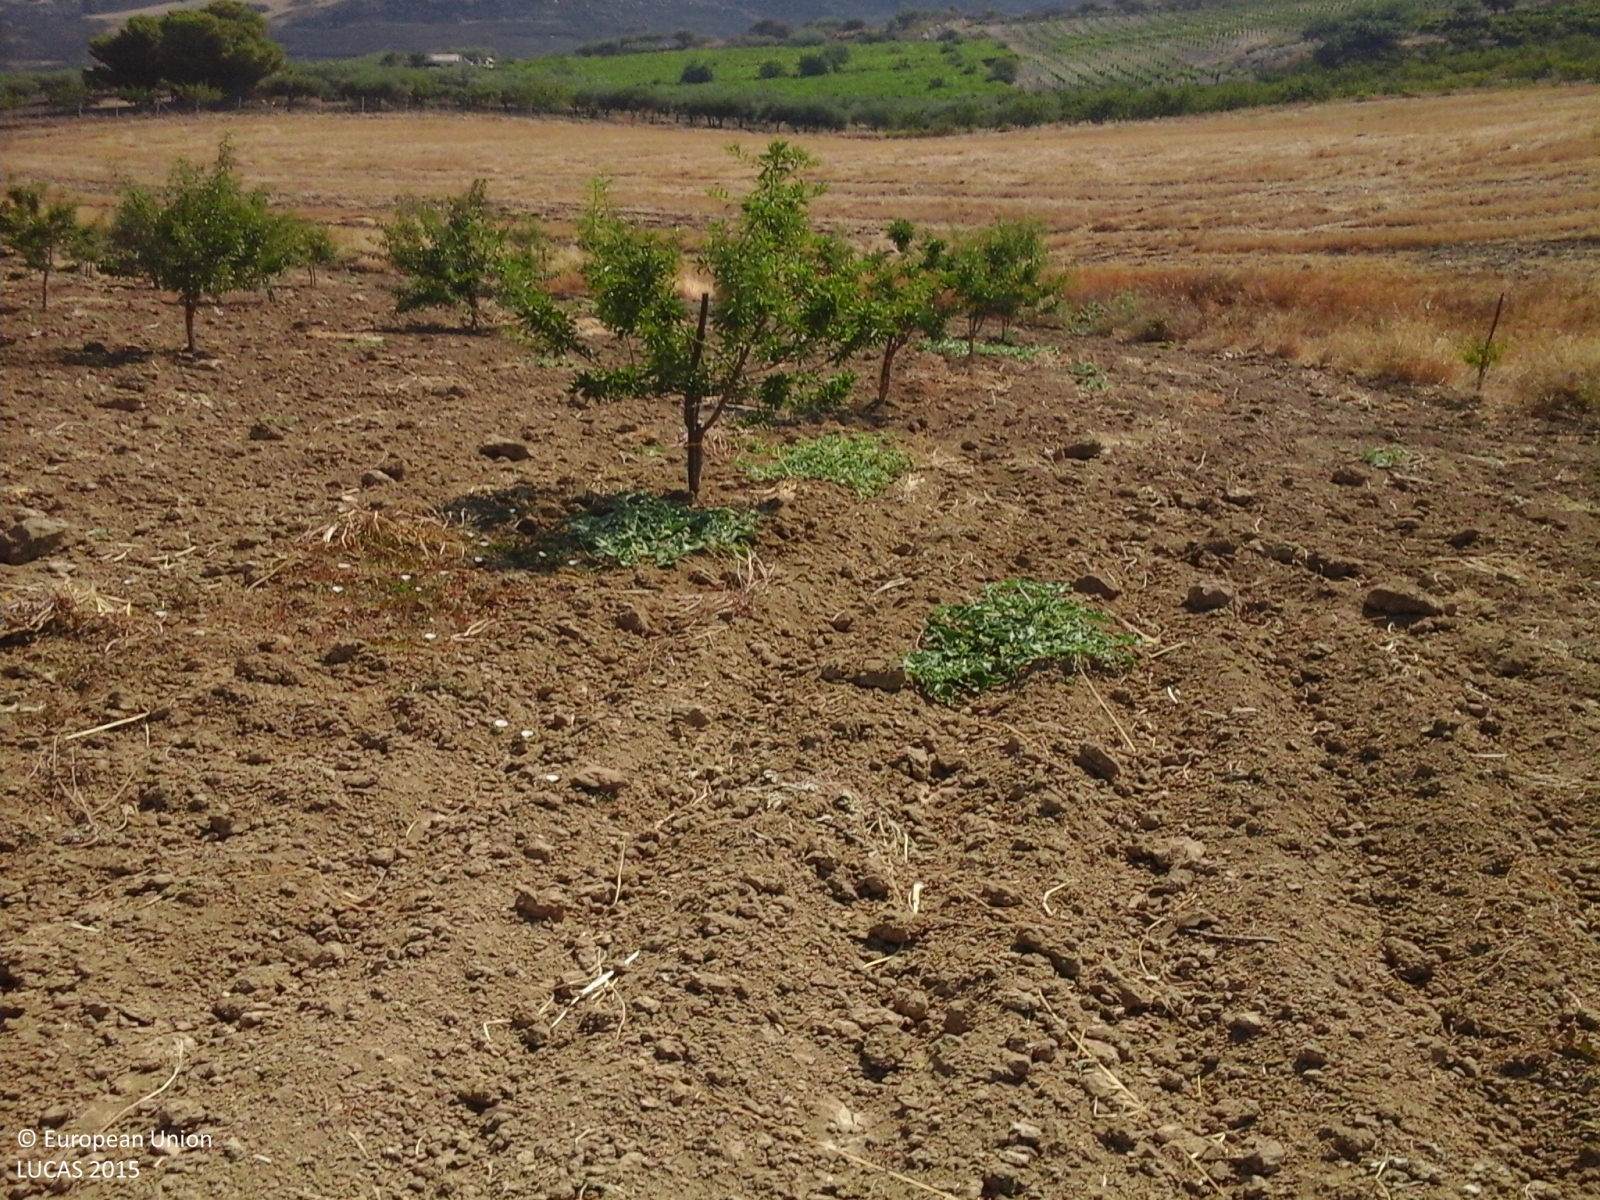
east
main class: Cropland
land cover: Nuts trees
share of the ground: > 75 %
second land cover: Other bare soil
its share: > 75 %
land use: Agriculture (excluding fallow land and kitchen gardens)
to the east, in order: Nuts trees; Other bare soil; Ditches and canals; Durum wheat; Spontaneously vegetated surfaces; Fences; Nuts trees; Grass margins; Other fruit trees and berries; Grass margins; Vineyards; Grass margins; Vineyards
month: July
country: IT
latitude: 37.2771
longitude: 14.1074
